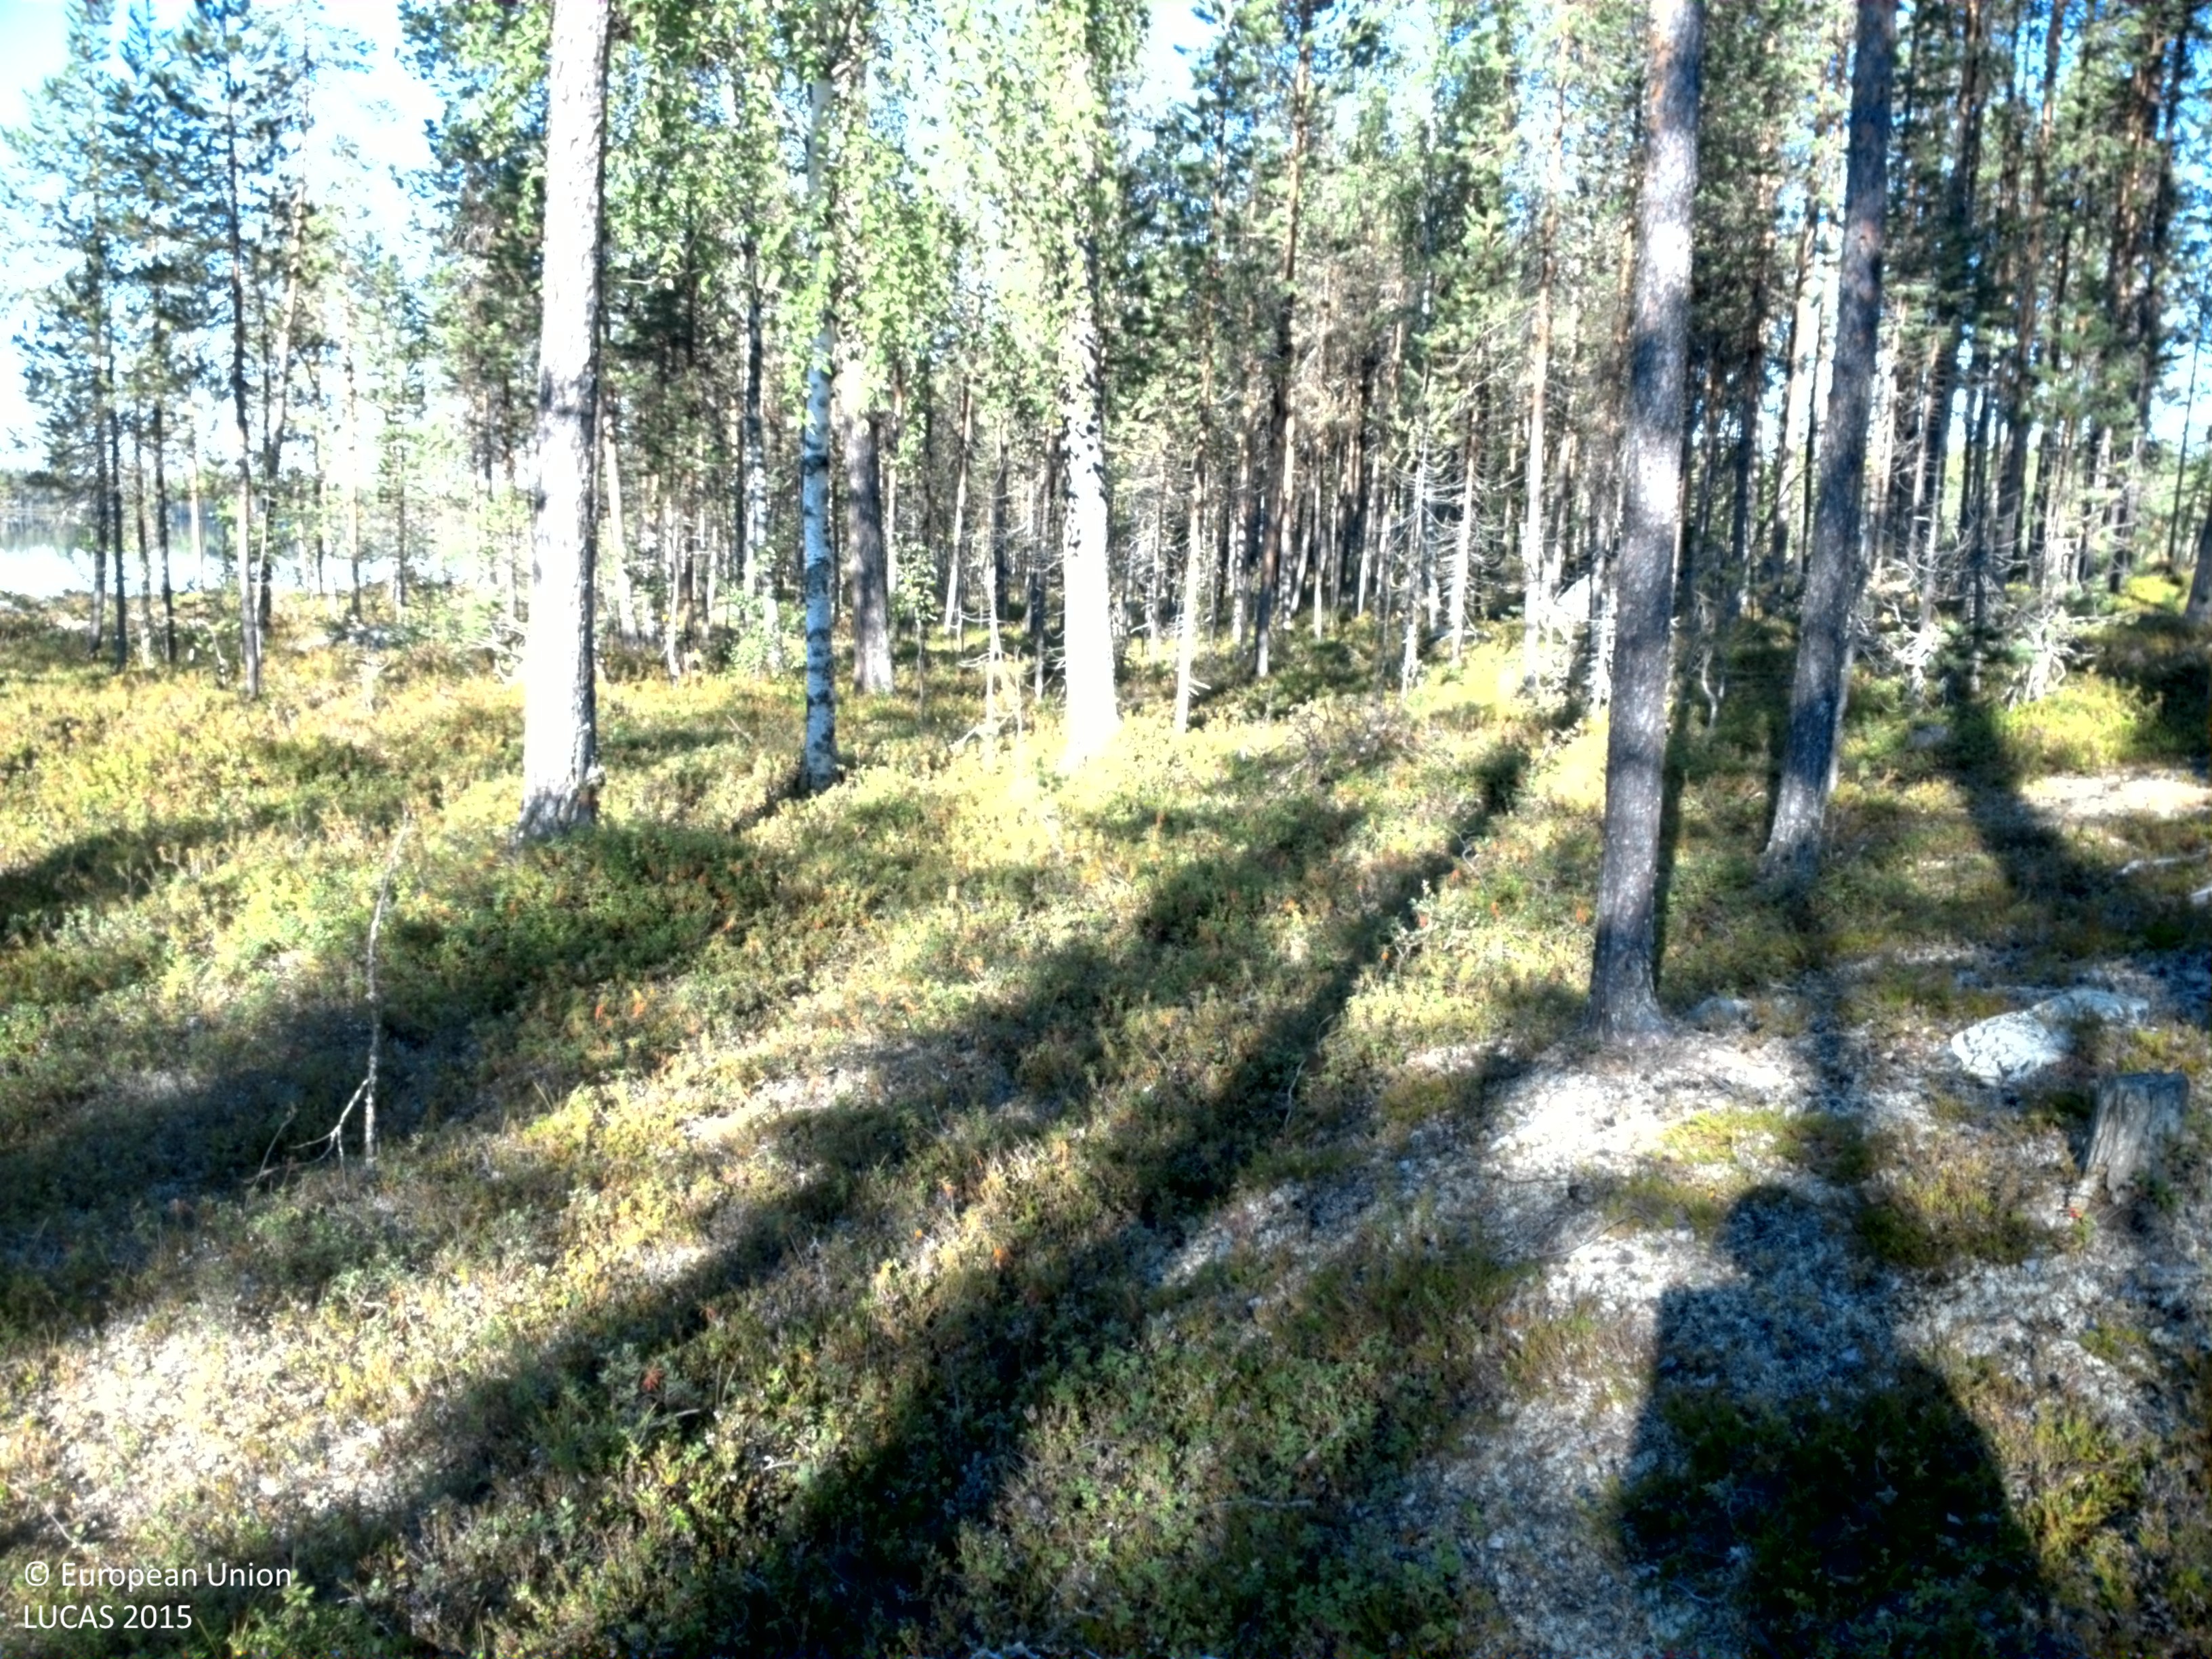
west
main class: Woodland
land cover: Pine dominated coniferous woodland
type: boreal forest
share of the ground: 25 - 50 %
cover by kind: shrubs 60 %, coniferous forest trees 25 %, lichens and mosses 10 %, consolidated bare surface 5 %
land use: Forestry
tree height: > 5 m
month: August
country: SE
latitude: 66.6570
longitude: 19.6537
